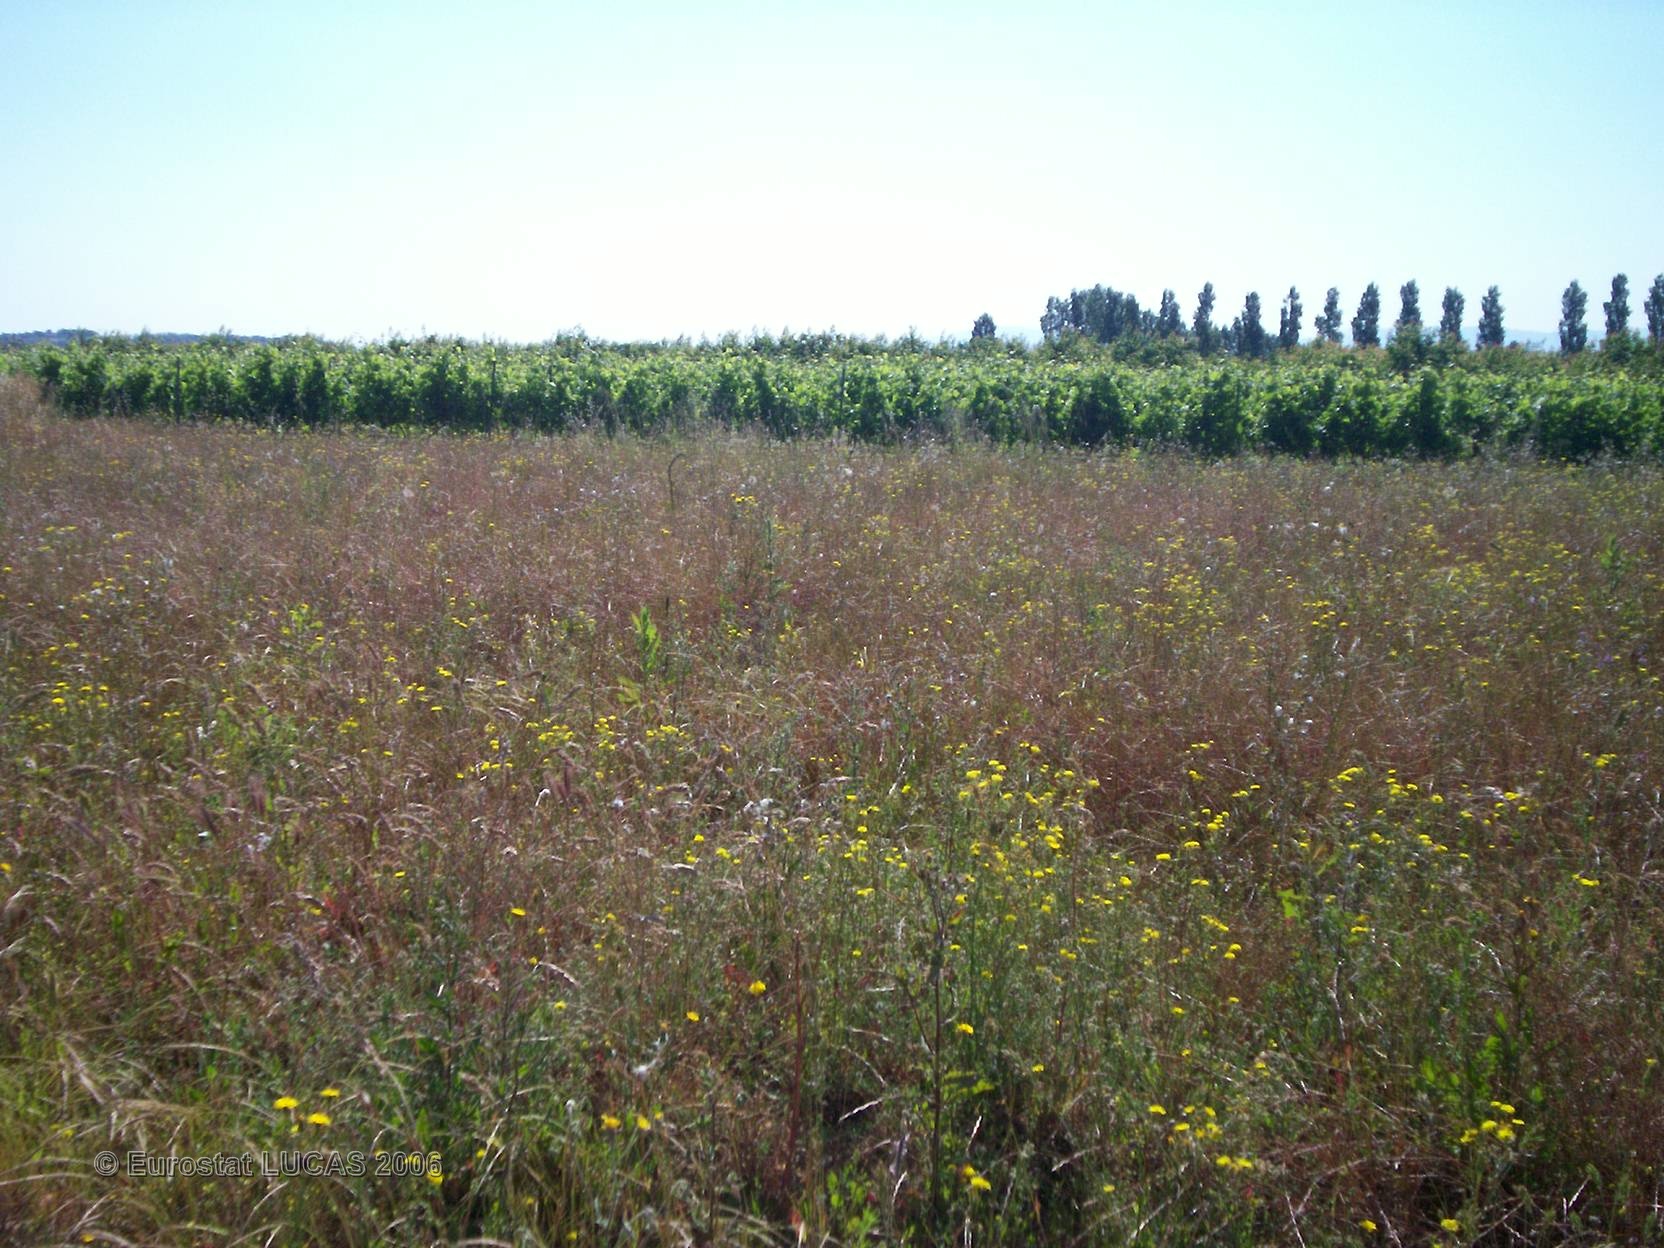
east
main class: Grassland
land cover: Grassland without tree/shrub cover
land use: Fallow land
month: June
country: FR
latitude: 45.0556
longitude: 4.8880
